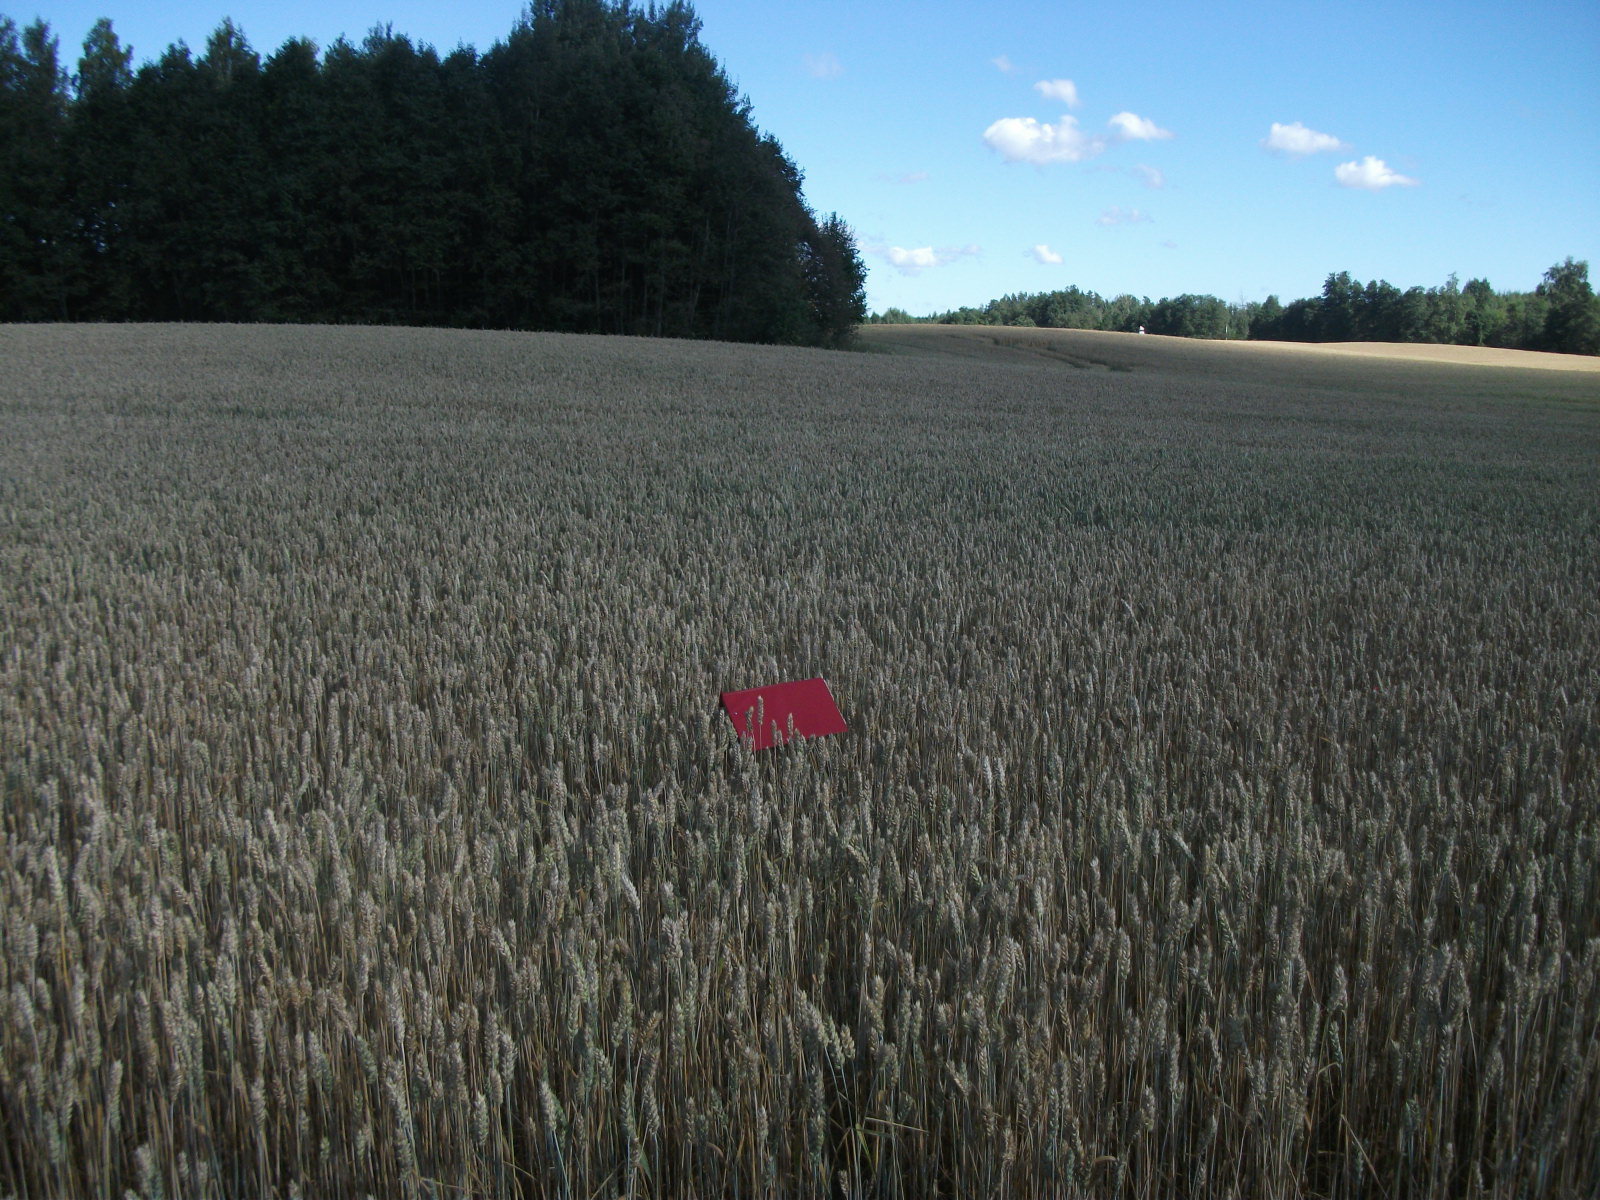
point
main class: Cropland
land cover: Common wheat
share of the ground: > 75 %
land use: Agriculture (excluding fallow land and kitchen gardens)
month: August
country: LV
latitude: 56.6994
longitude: 26.2924
